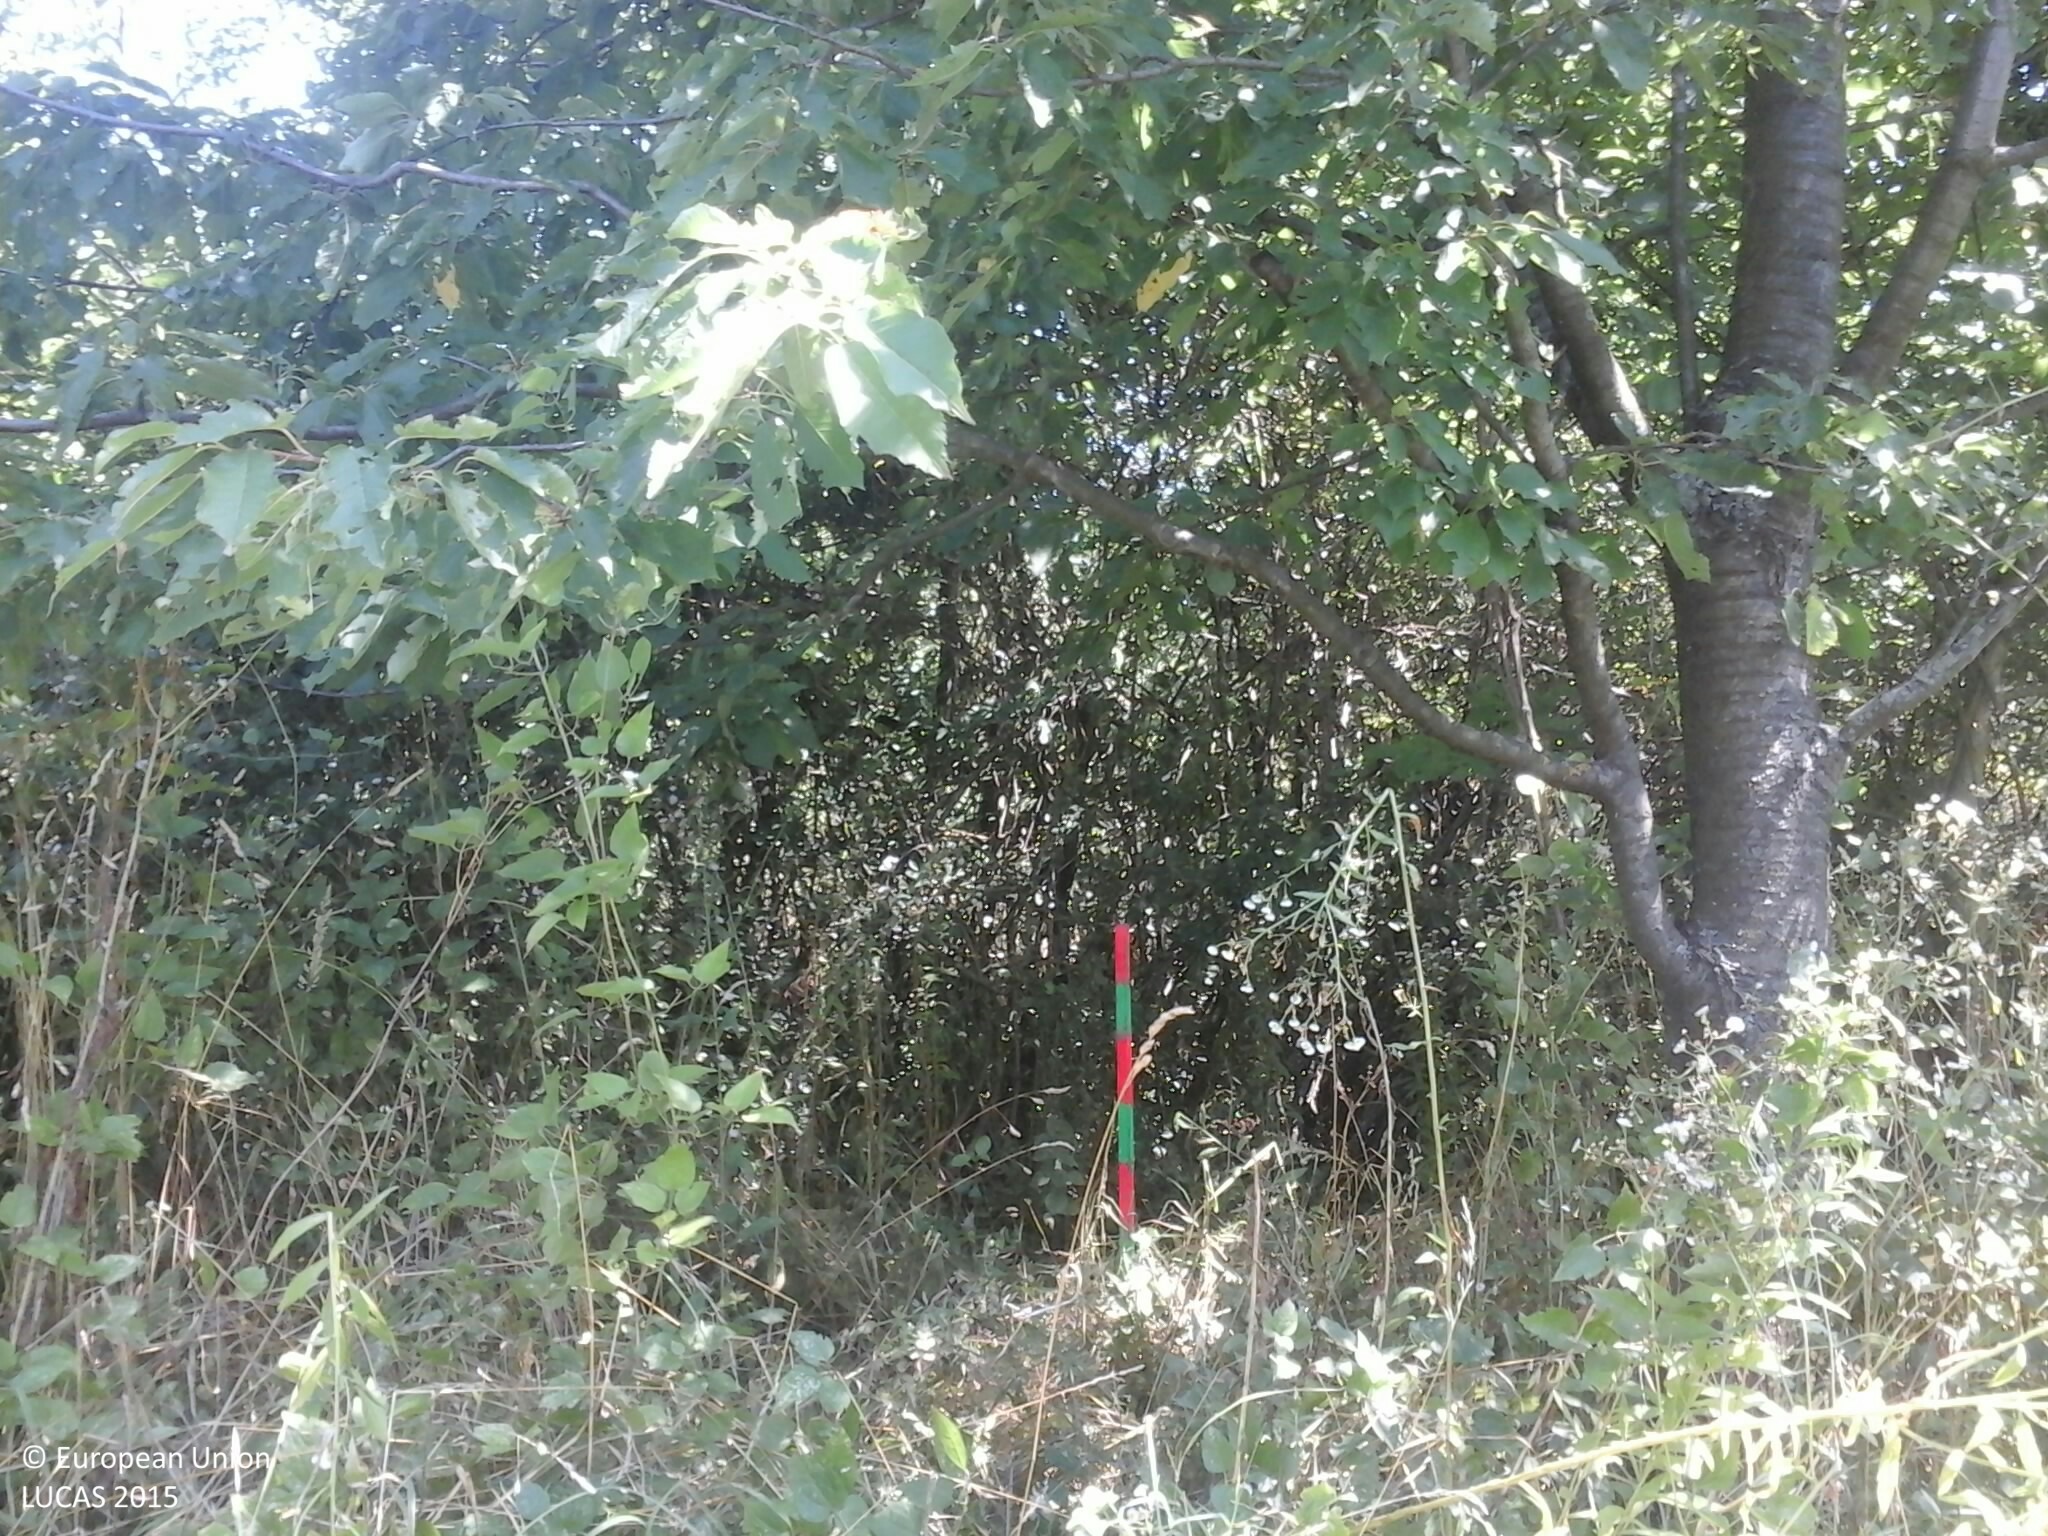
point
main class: Shrubland
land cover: Shrubland with sparse tree cover
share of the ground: > 75 %
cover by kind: shrubs 75 %, herbaceous plants 20 %, broadleaved forest trees 5 %
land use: Semi-natural and natural areas not in use
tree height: < 5 m
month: August
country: HU
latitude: 46.7781
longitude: 17.9581
